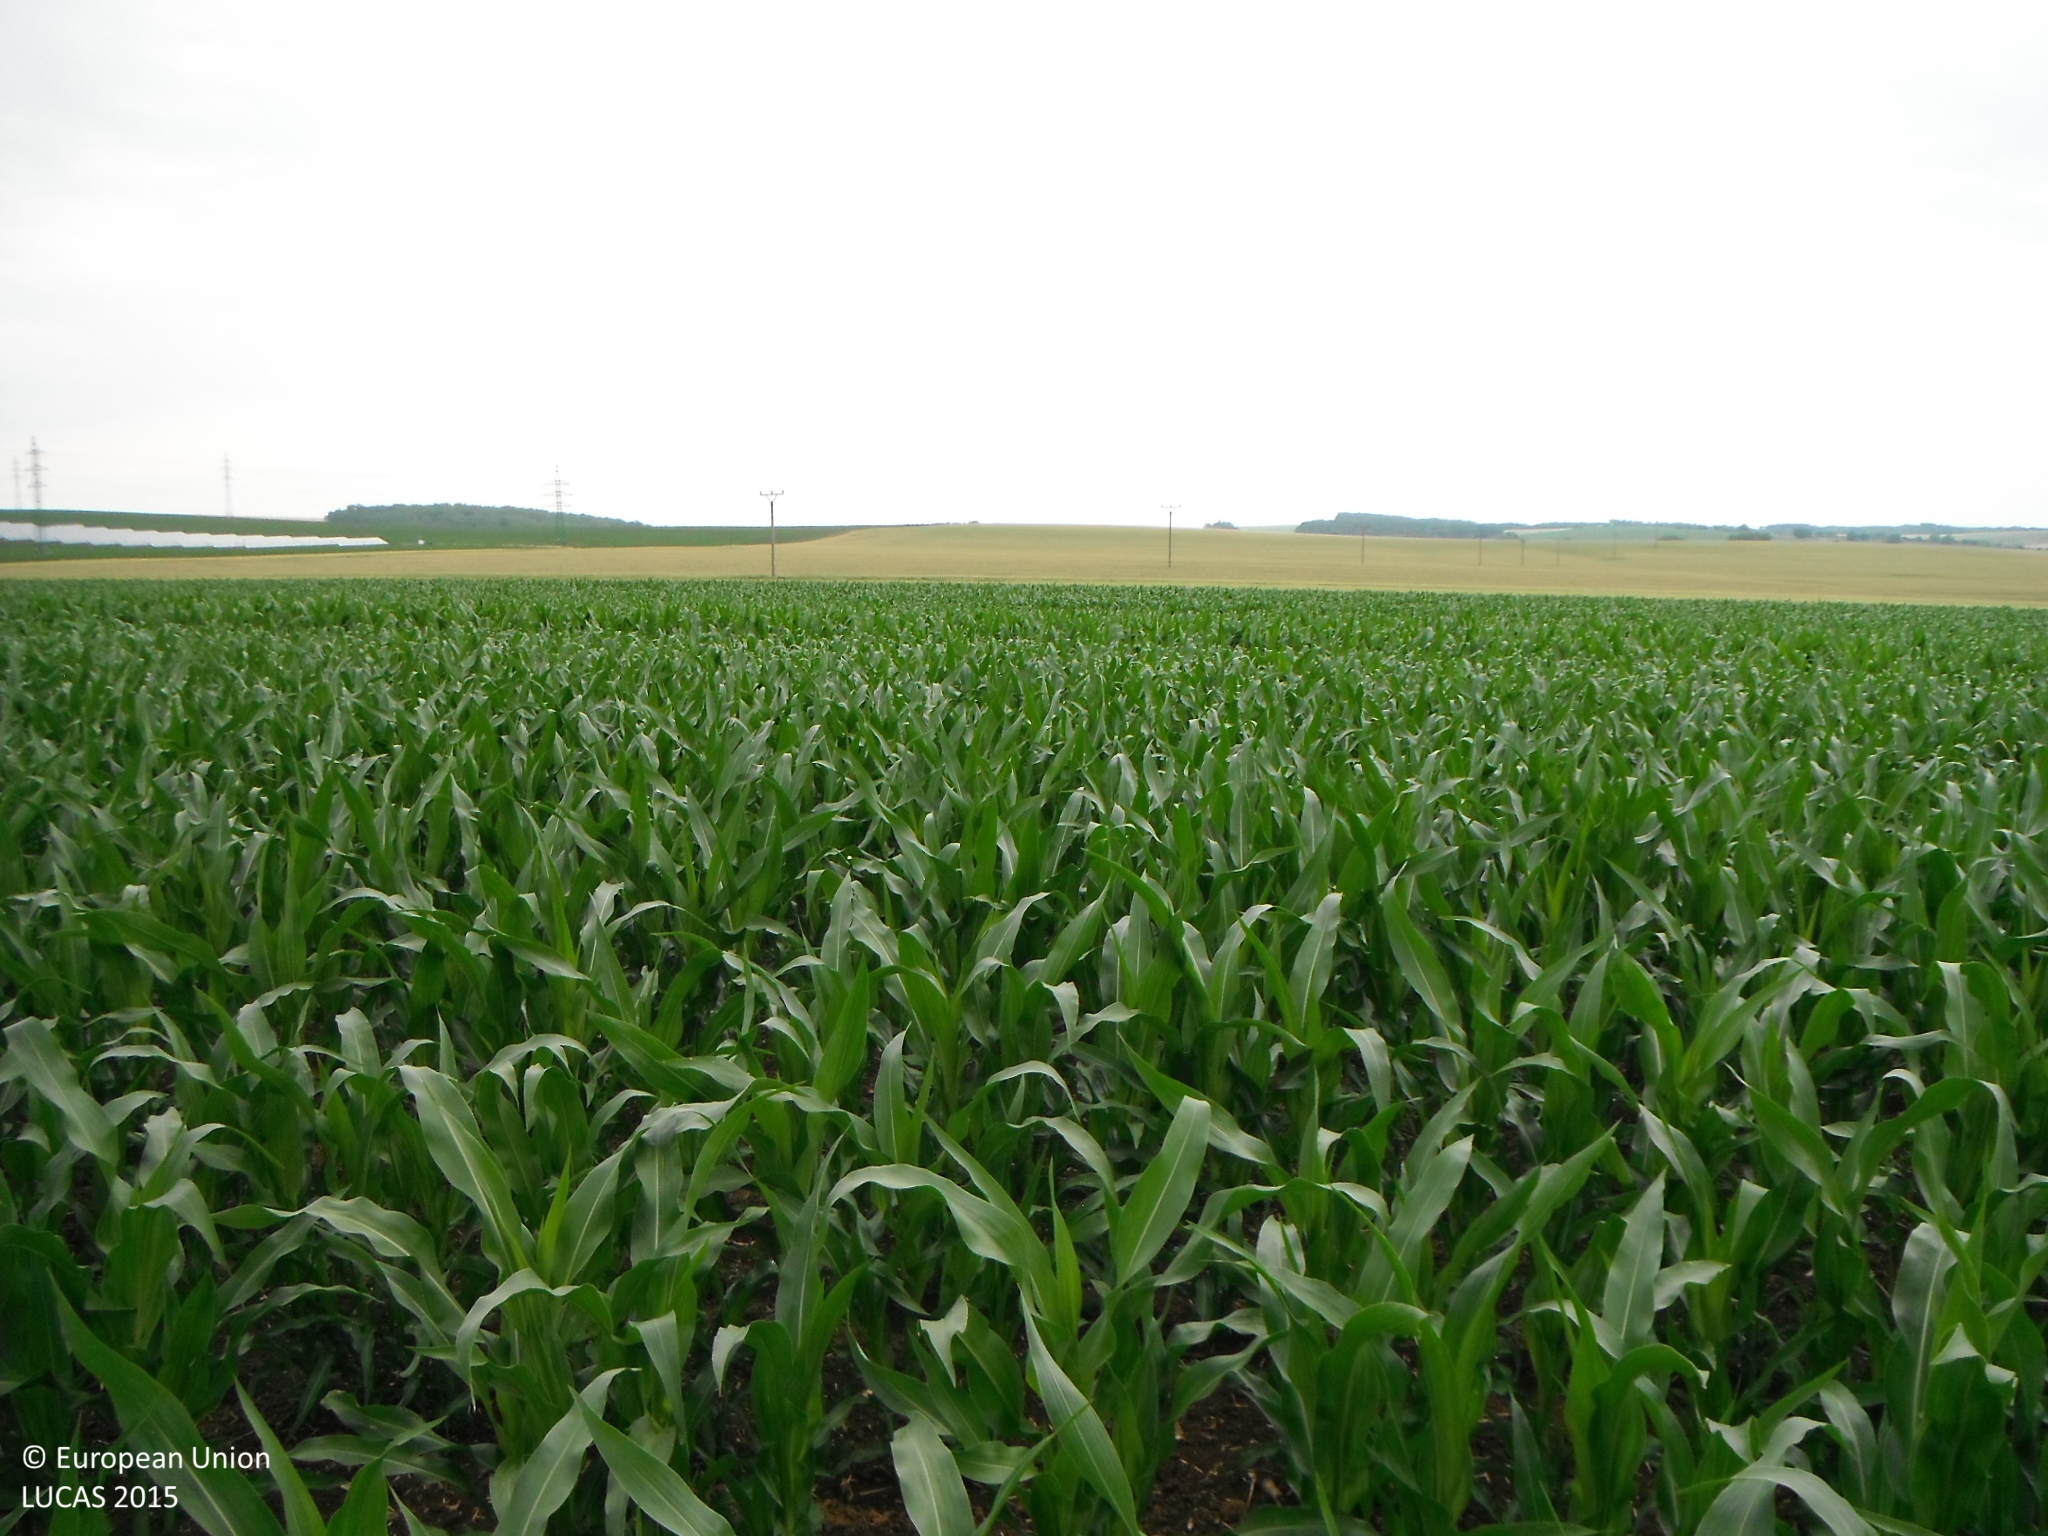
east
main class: Cropland
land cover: Maize
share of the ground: > 75 %
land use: Agriculture (excluding fallow land and kitchen gardens)
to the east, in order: Maize; Barley; Common wheat; Electric lines; Common wheat
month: June
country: SK
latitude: 48.1123
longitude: 18.9512
